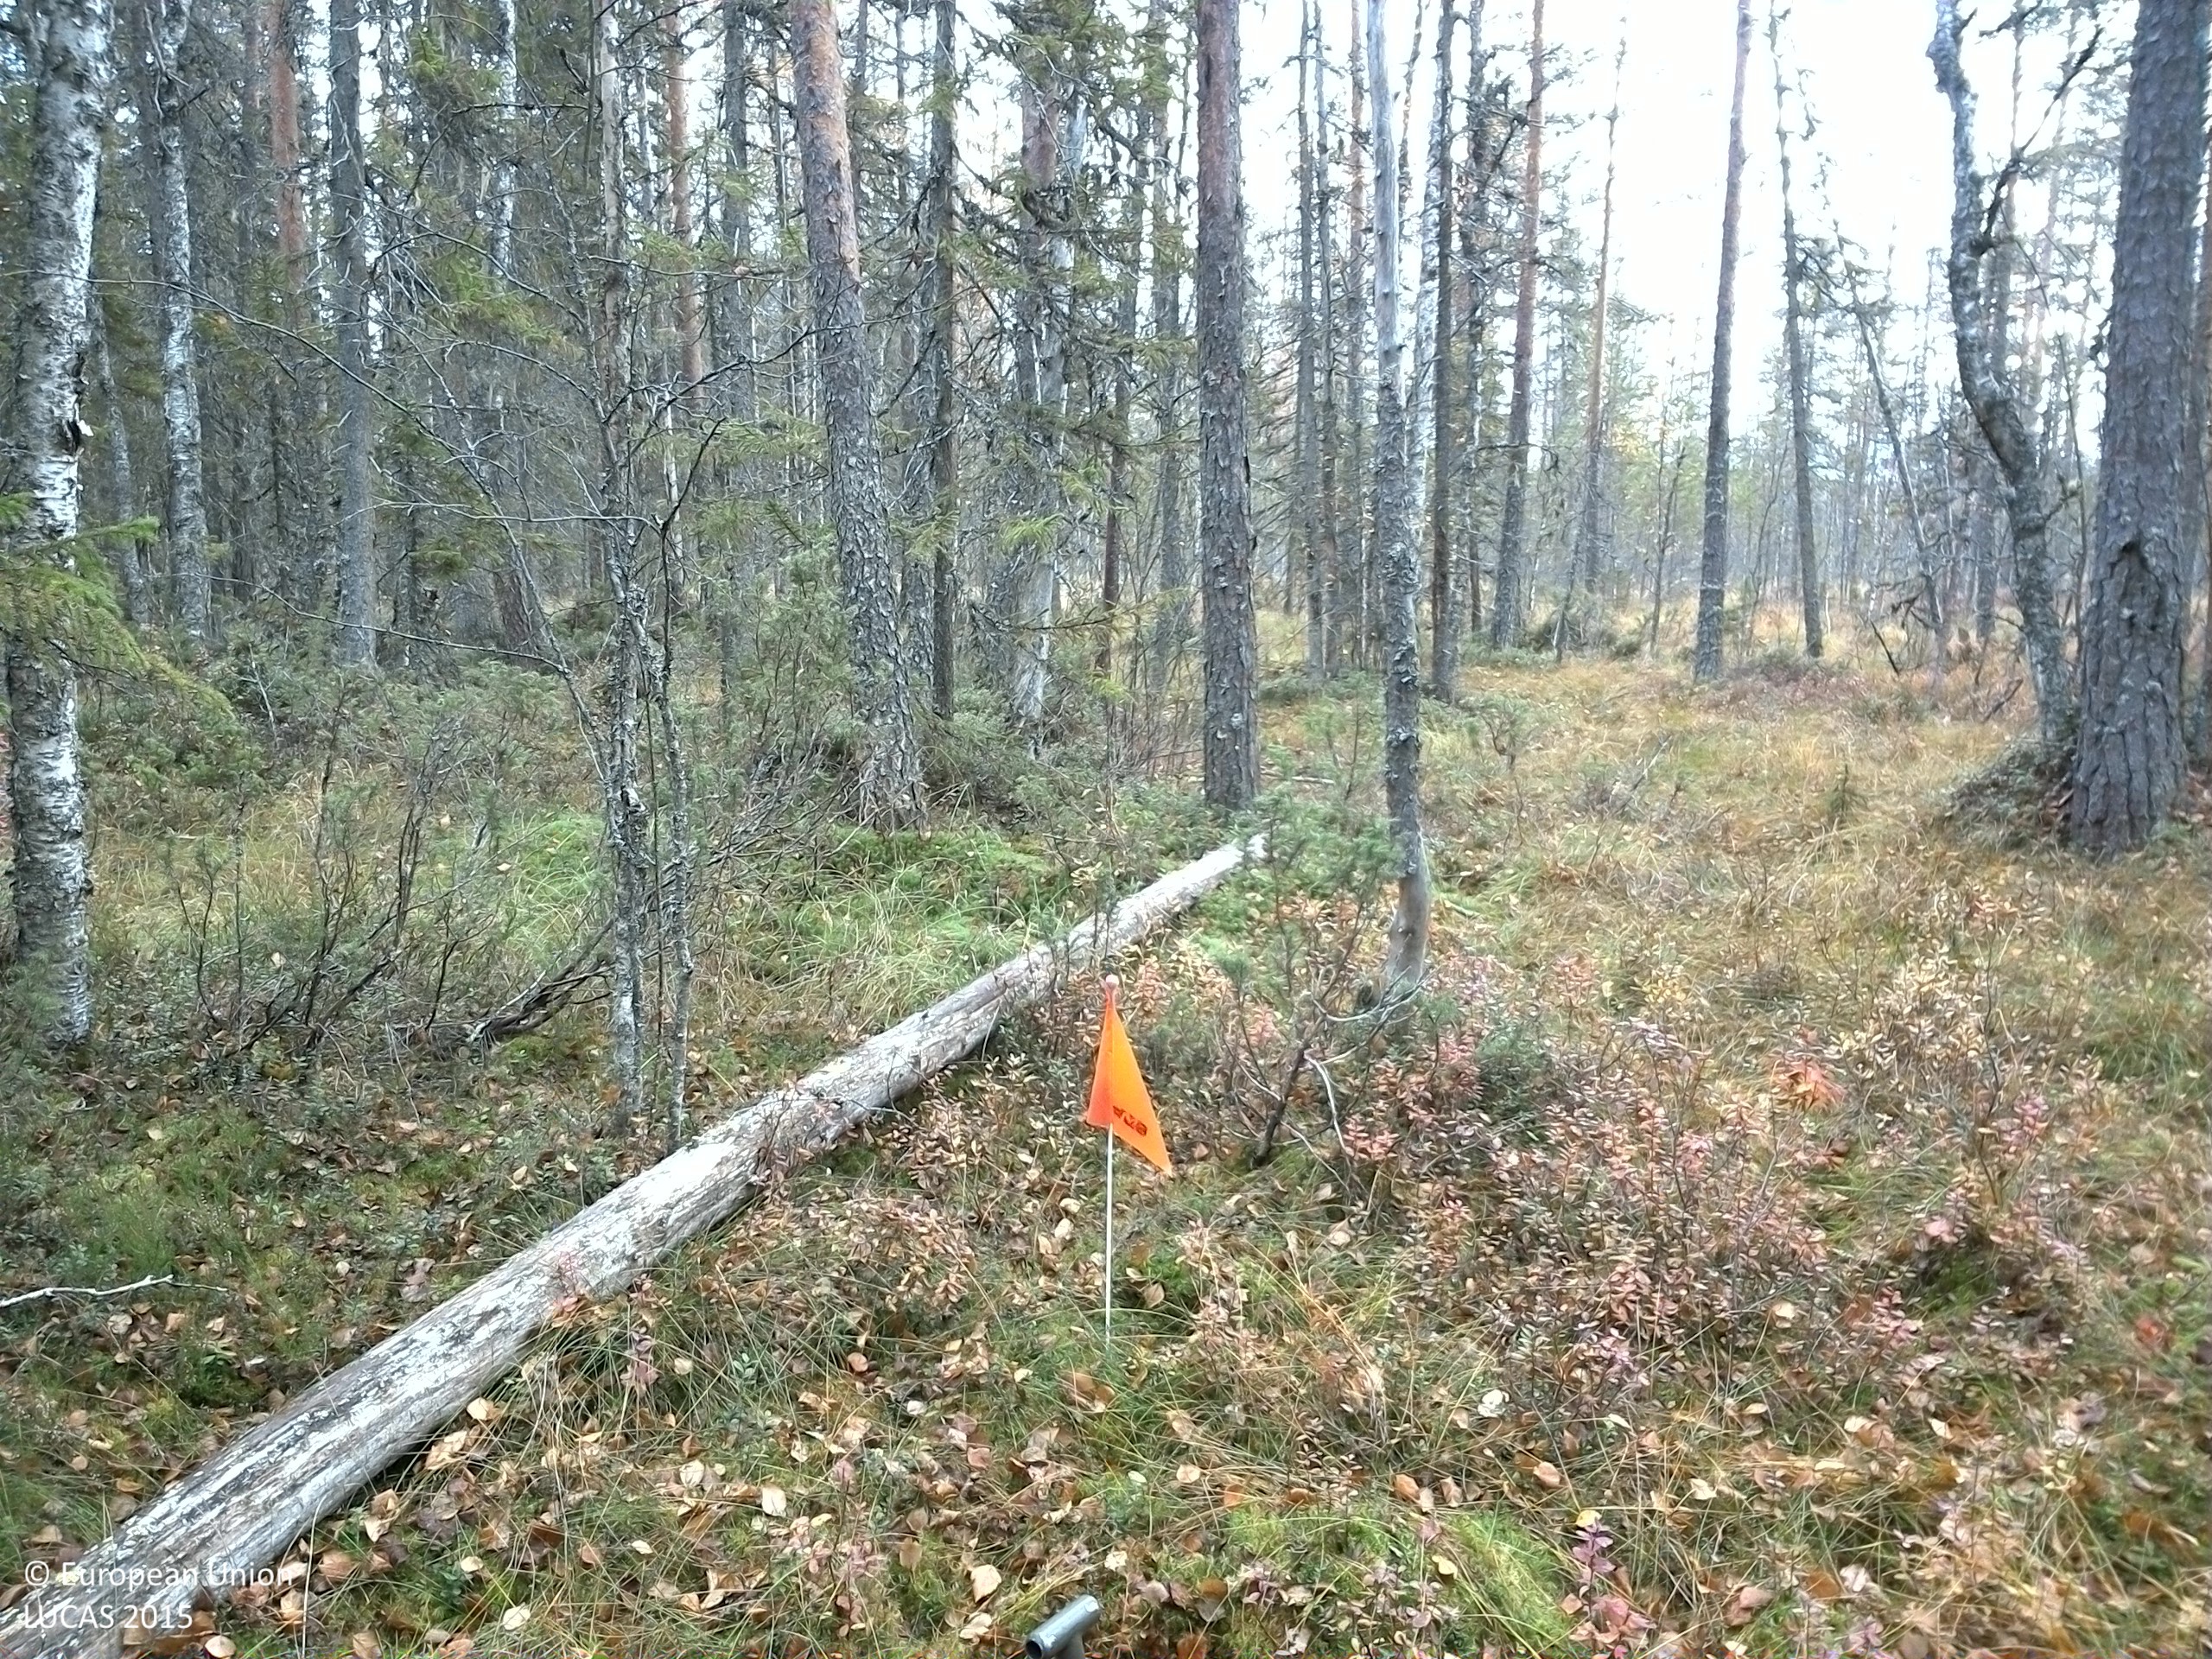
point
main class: Woodland
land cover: Pine dominated mixed woodland
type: boreal forest
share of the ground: 50 - 75 %
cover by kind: coniferous forest trees 35 %, shrubs 20 %, lichens and mosses 20 %, broadleaved forest trees 15 %, herbaceous plants 10 %
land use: Forestry
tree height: > 5 m
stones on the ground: < 10 %
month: October
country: SE
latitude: 61.2527
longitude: 14.2546
